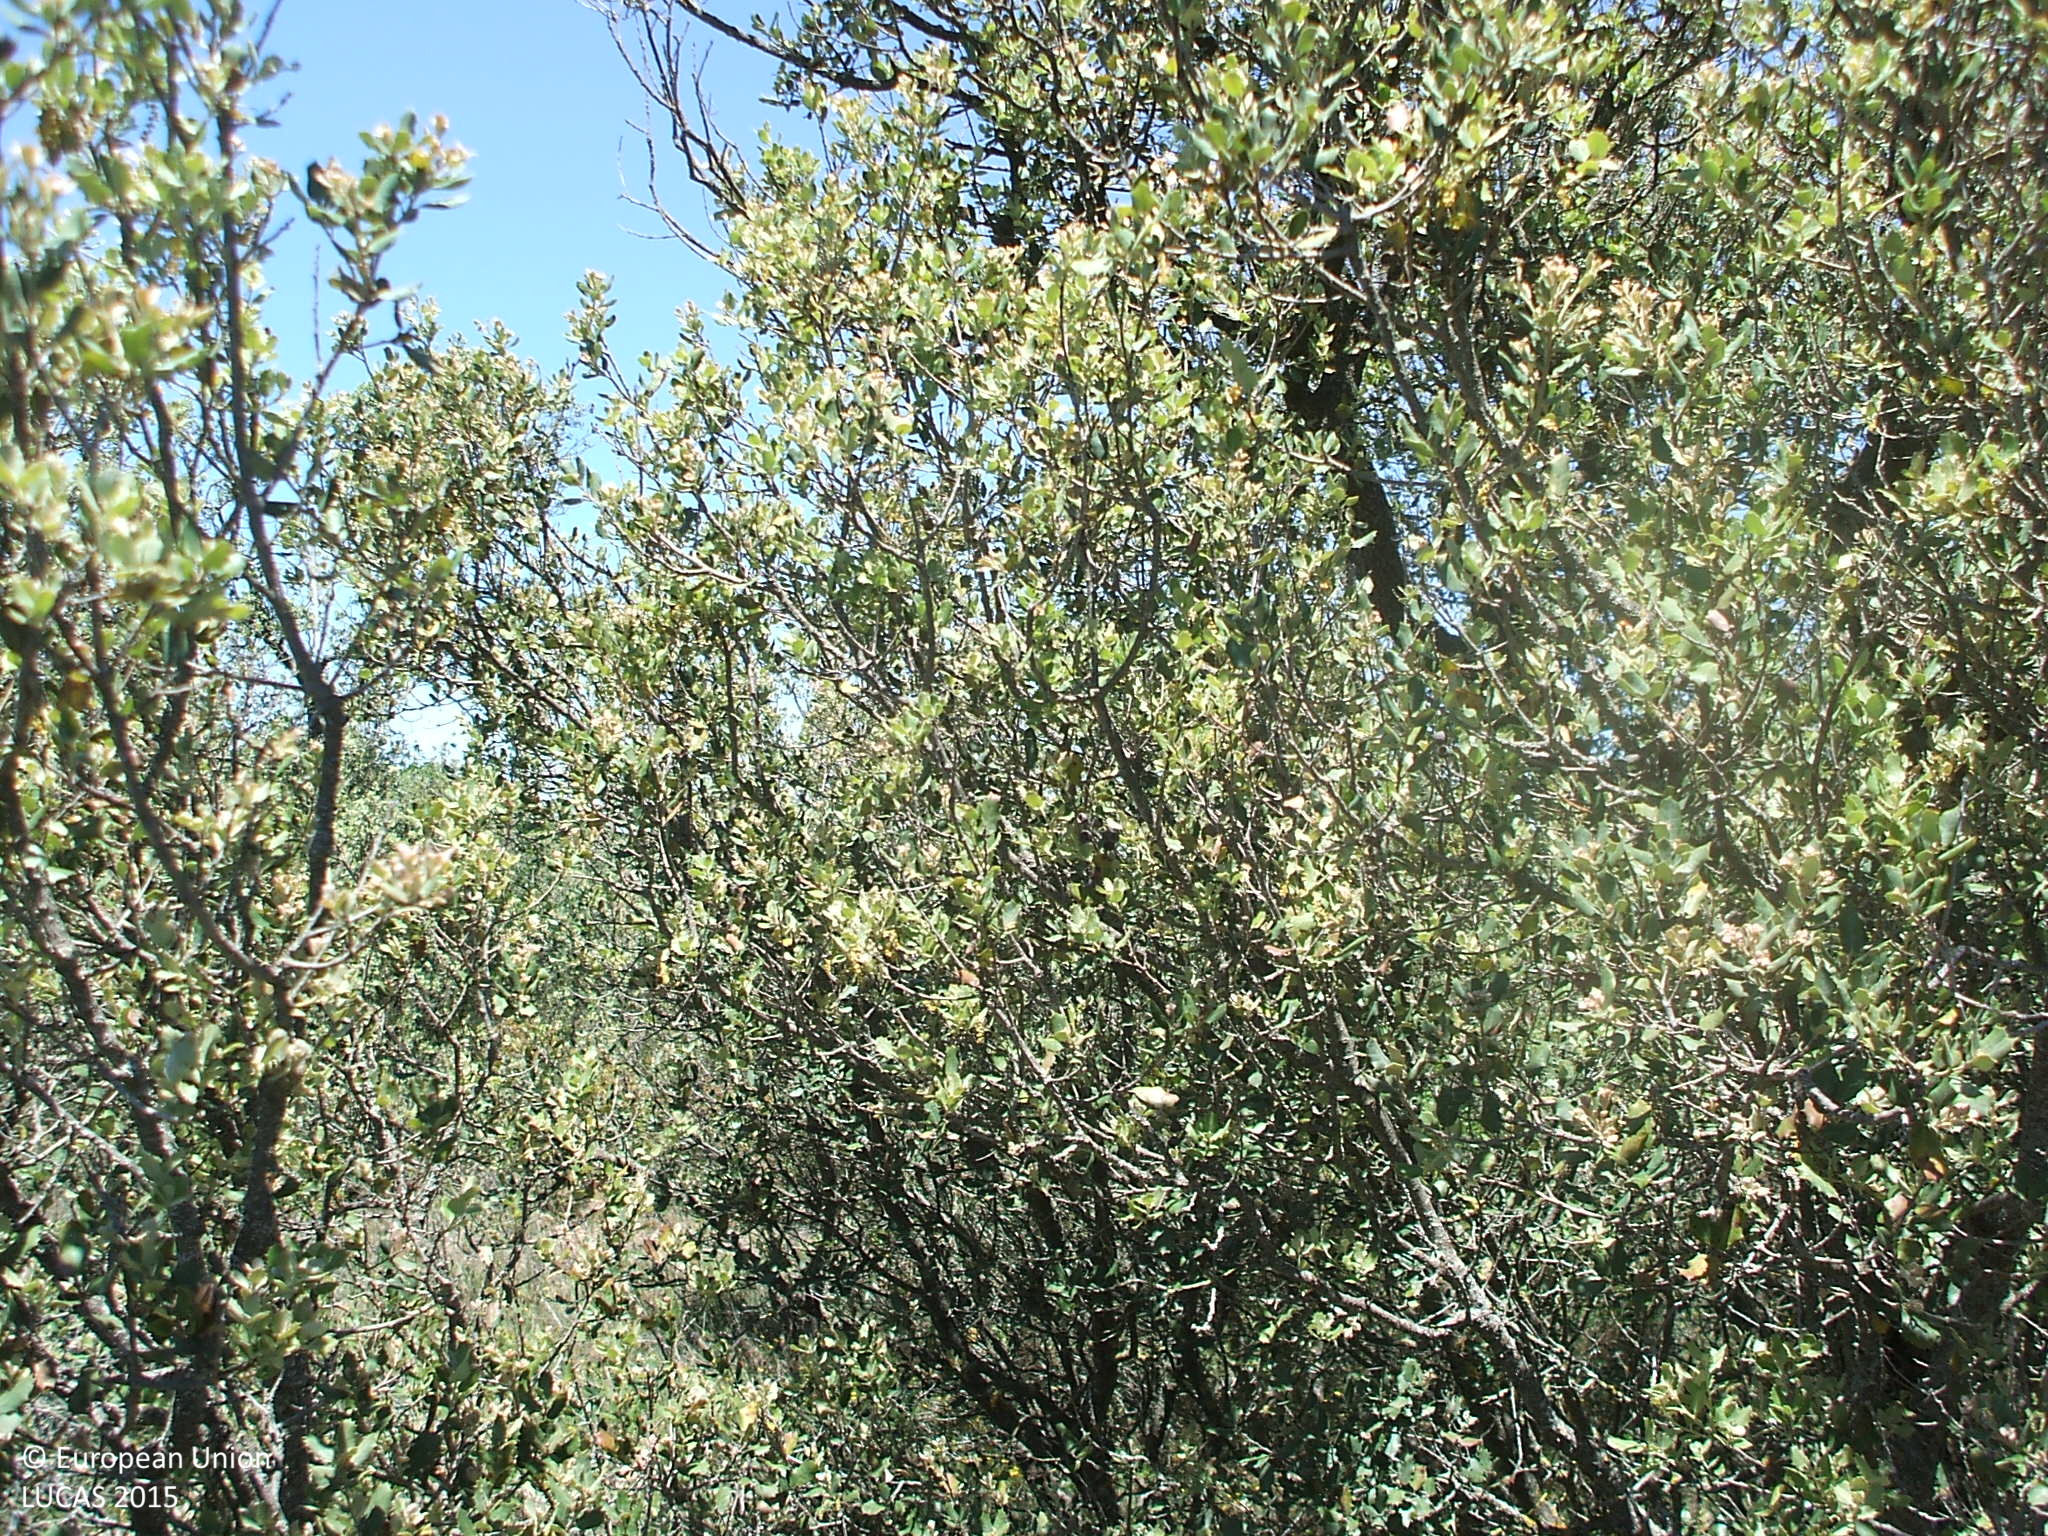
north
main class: Woodland
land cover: Broadleaved woodland
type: broadleaved evergreen forest
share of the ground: 50 - 75 %
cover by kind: broadleaved forest trees 70 %, shrubs 30 %
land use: Semi-natural and natural areas not in use
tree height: < 5 m
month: May
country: ES
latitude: 40.0061
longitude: -0.7233
